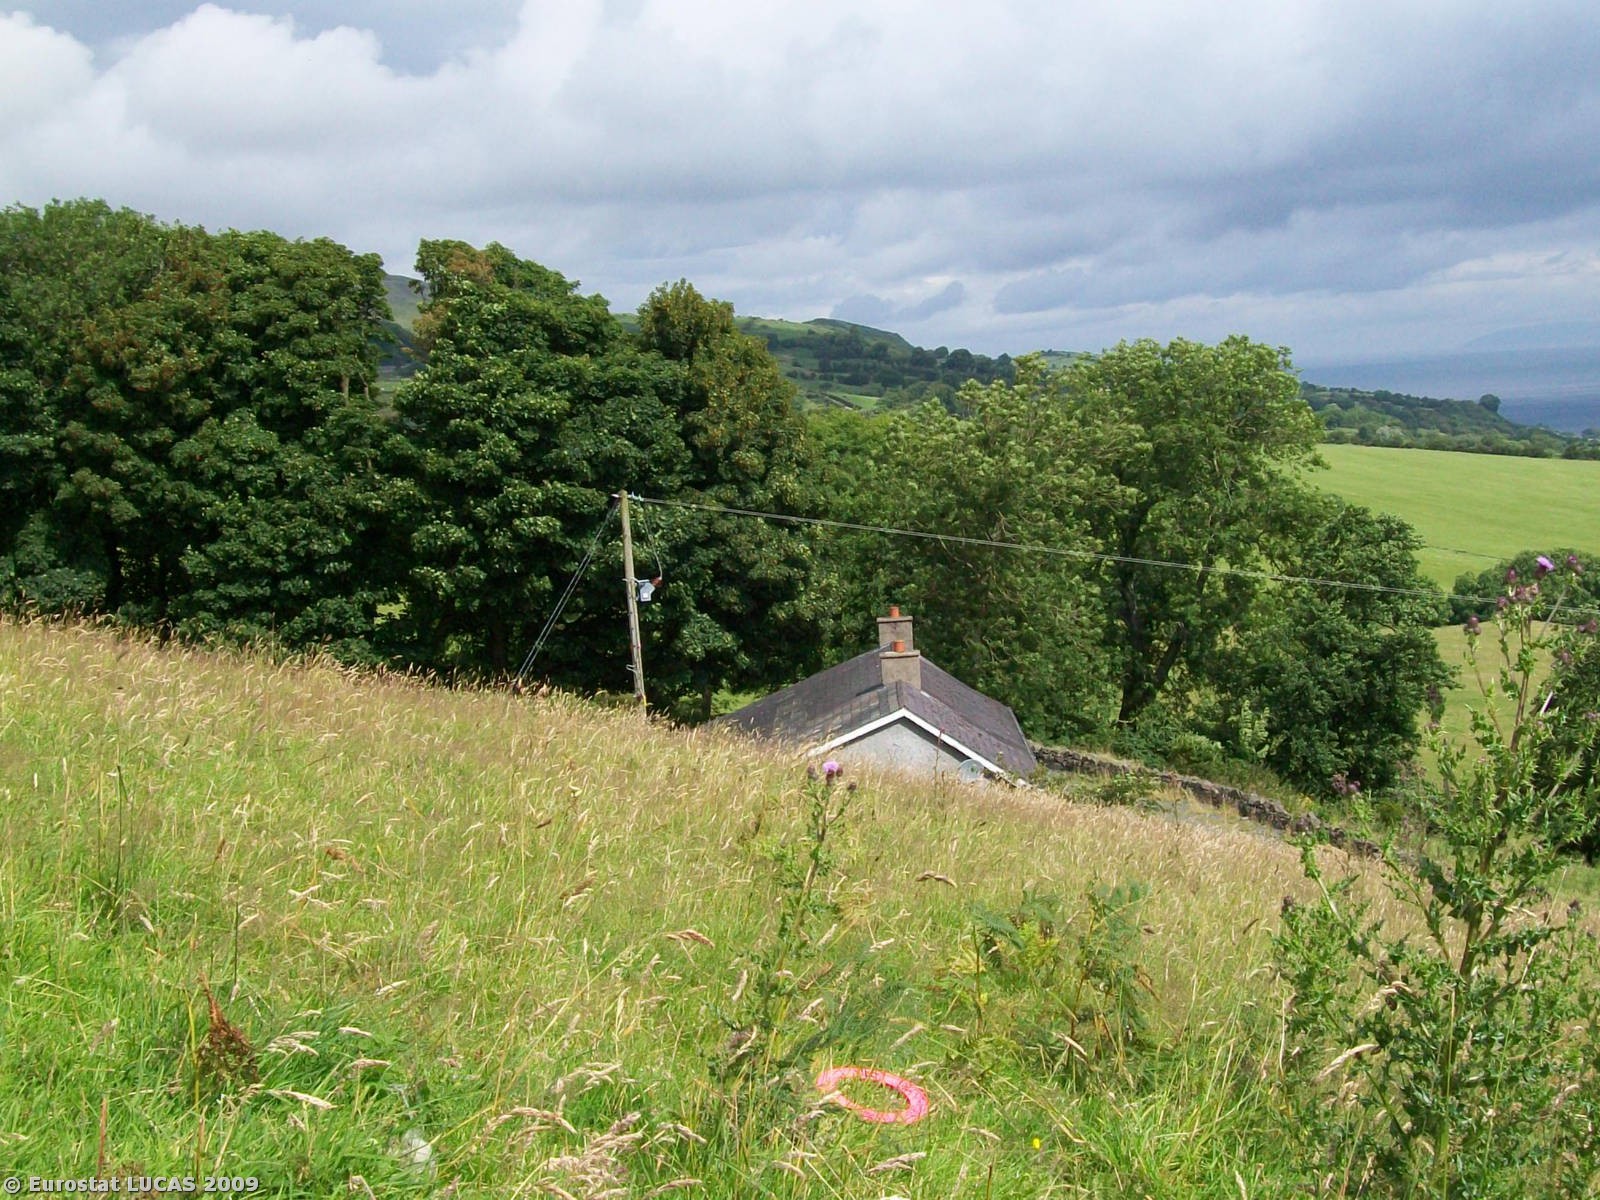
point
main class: Grassland
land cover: Grassland without tree/shrub cover
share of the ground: > 75 %
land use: Agriculture (excluding fallow land and kitchen gardens)
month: July
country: GB
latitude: 54.8929
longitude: -5.9000
